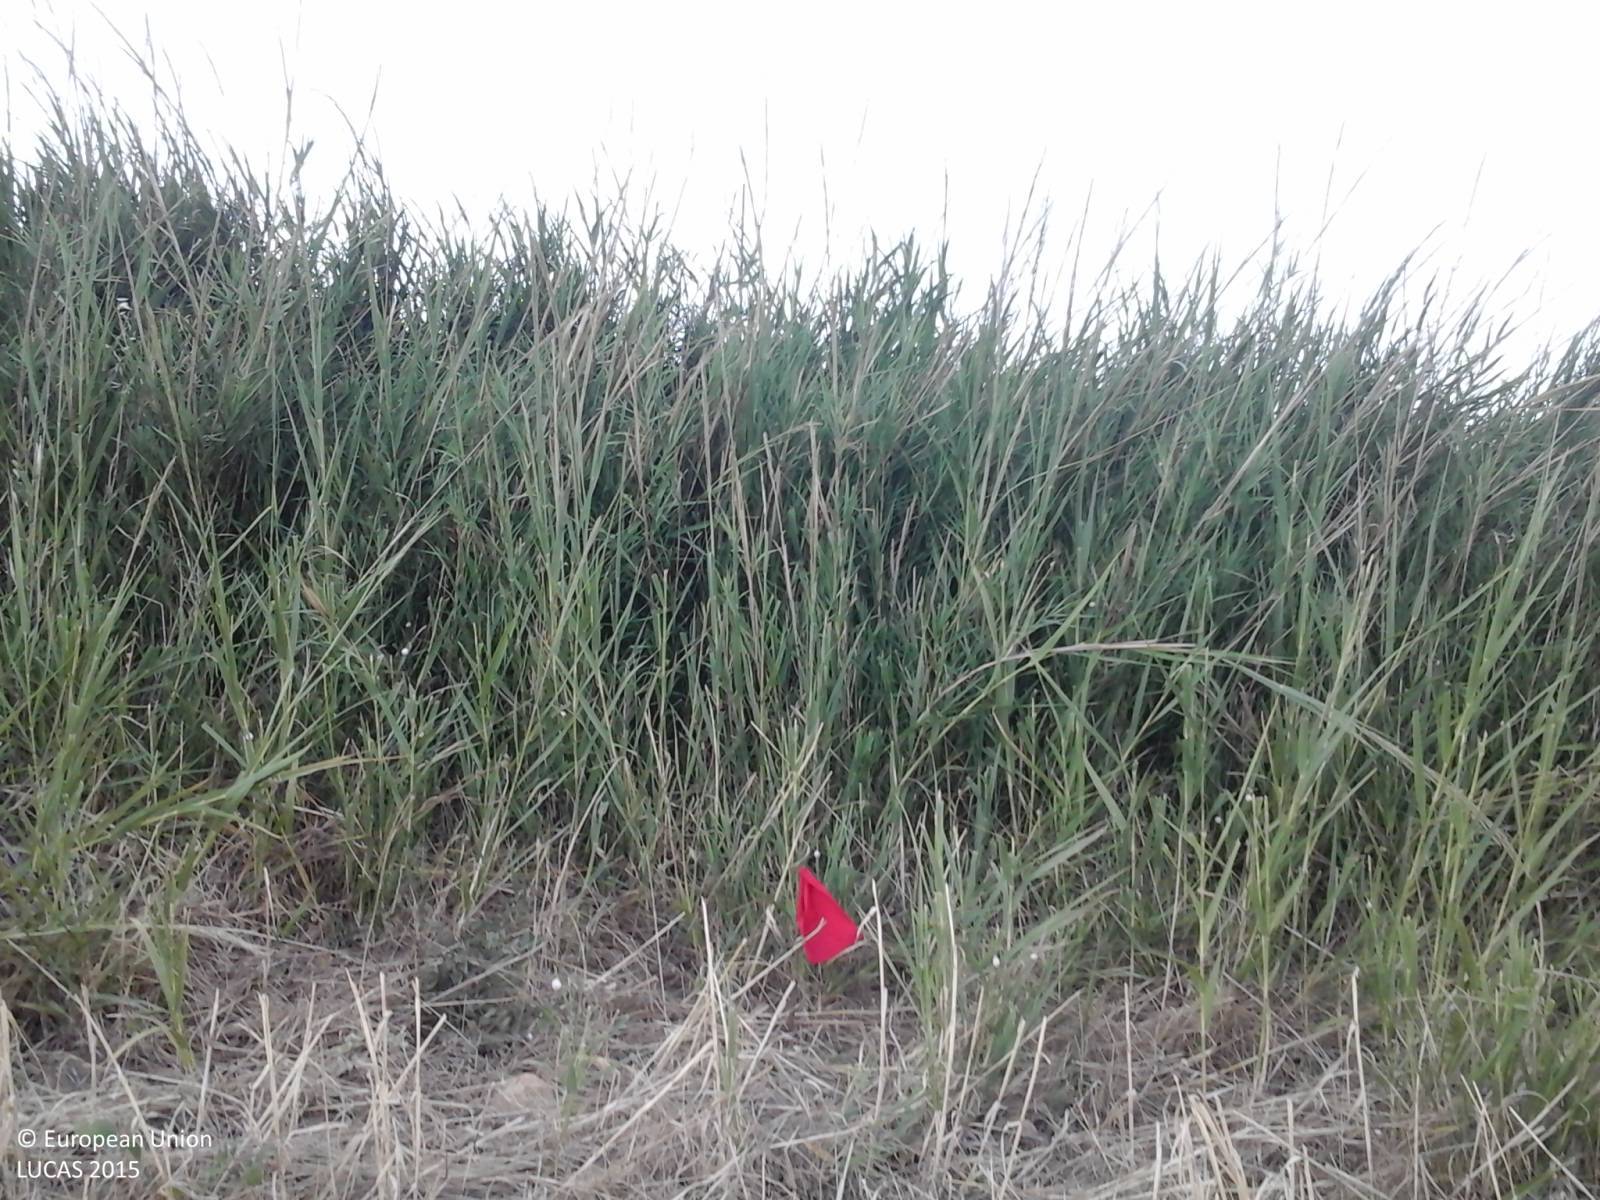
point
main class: Grassland
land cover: Grassland without tree/shrub cover
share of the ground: > 75 %
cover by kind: herbaceous plants 100 %
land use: Agriculture (excluding fallow land and kitchen gardens)
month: July
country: IT
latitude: 37.7849
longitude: 13.1899
